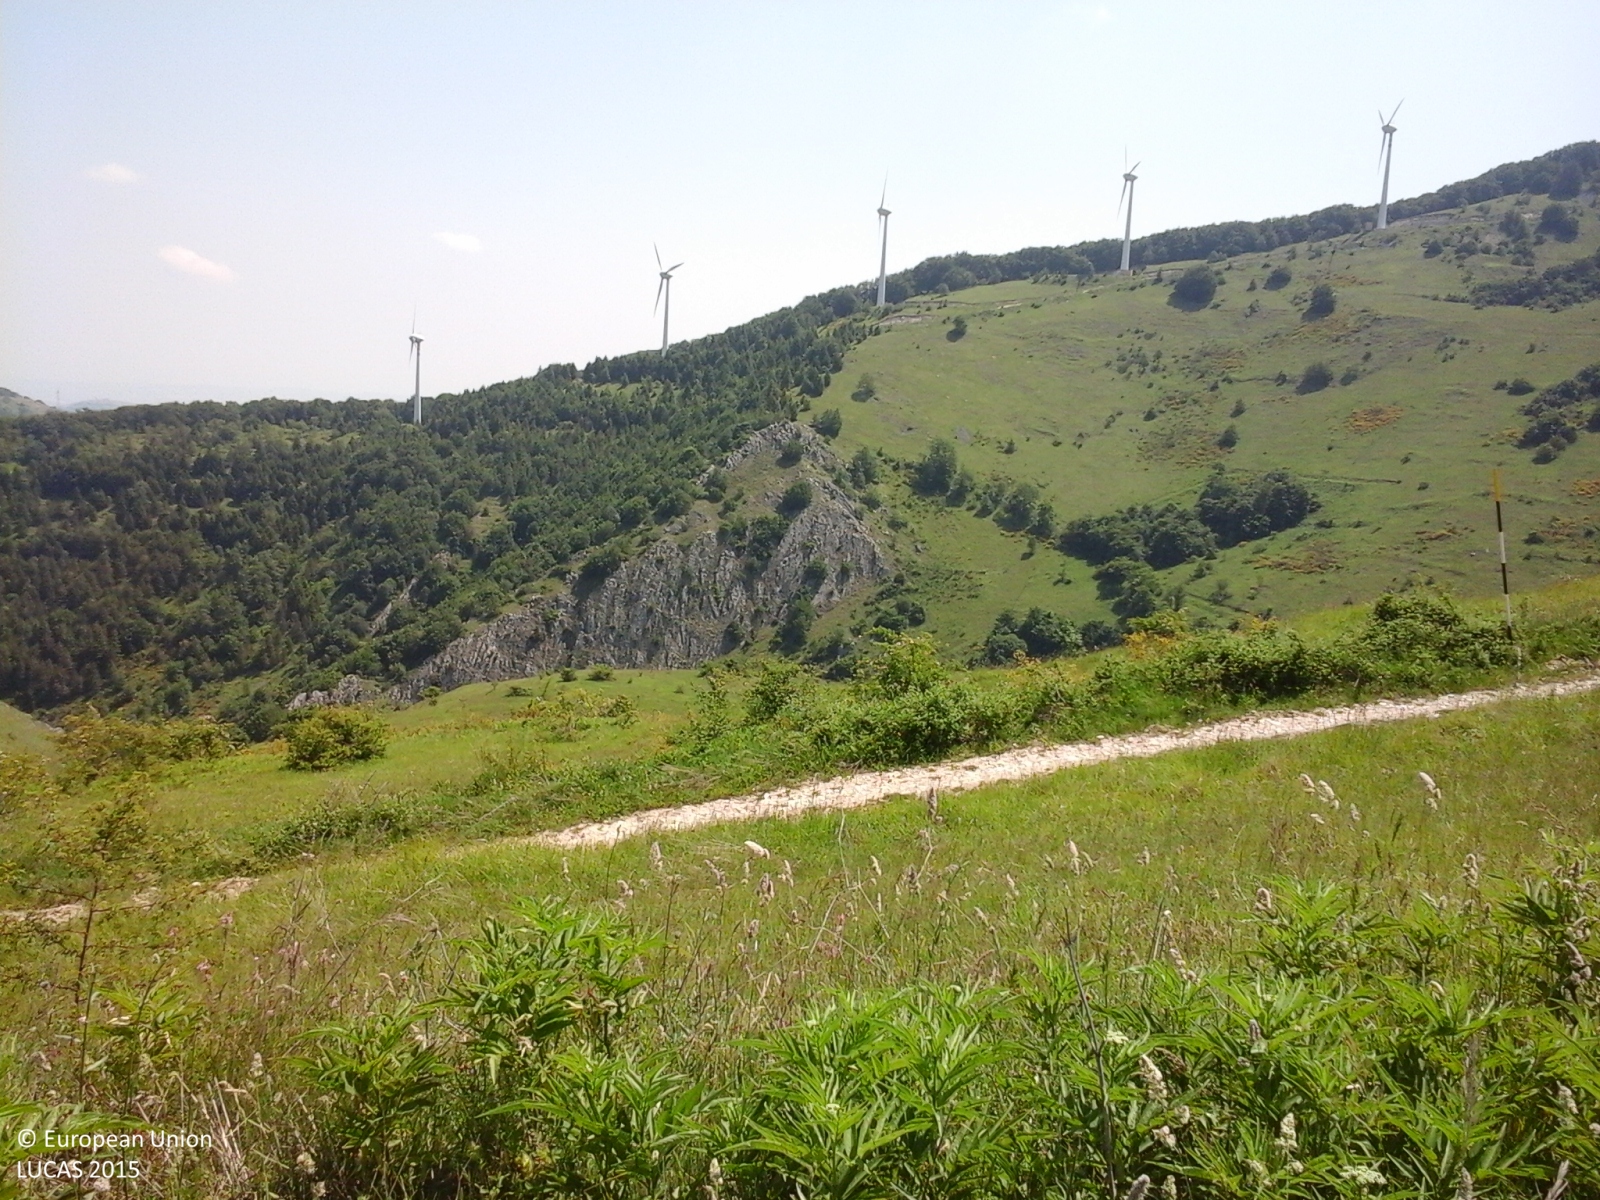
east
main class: Grassland
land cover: Grassland without tree/shrub cover
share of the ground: > 75 %
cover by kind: herbaceous plants 100 %
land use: Energy production
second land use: Agriculture (excluding fallow land and kitchen gardens)
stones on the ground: 10 - 25 %
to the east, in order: Grassland without tree/shrub cover; Tracks; Grassland without tree/shrub cover; Paved roads, cycling and walking lanes; Shrubland without tree cover; Grassland without tree/shrub cover
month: June
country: IT
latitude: 41.9439
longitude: 14.3884
